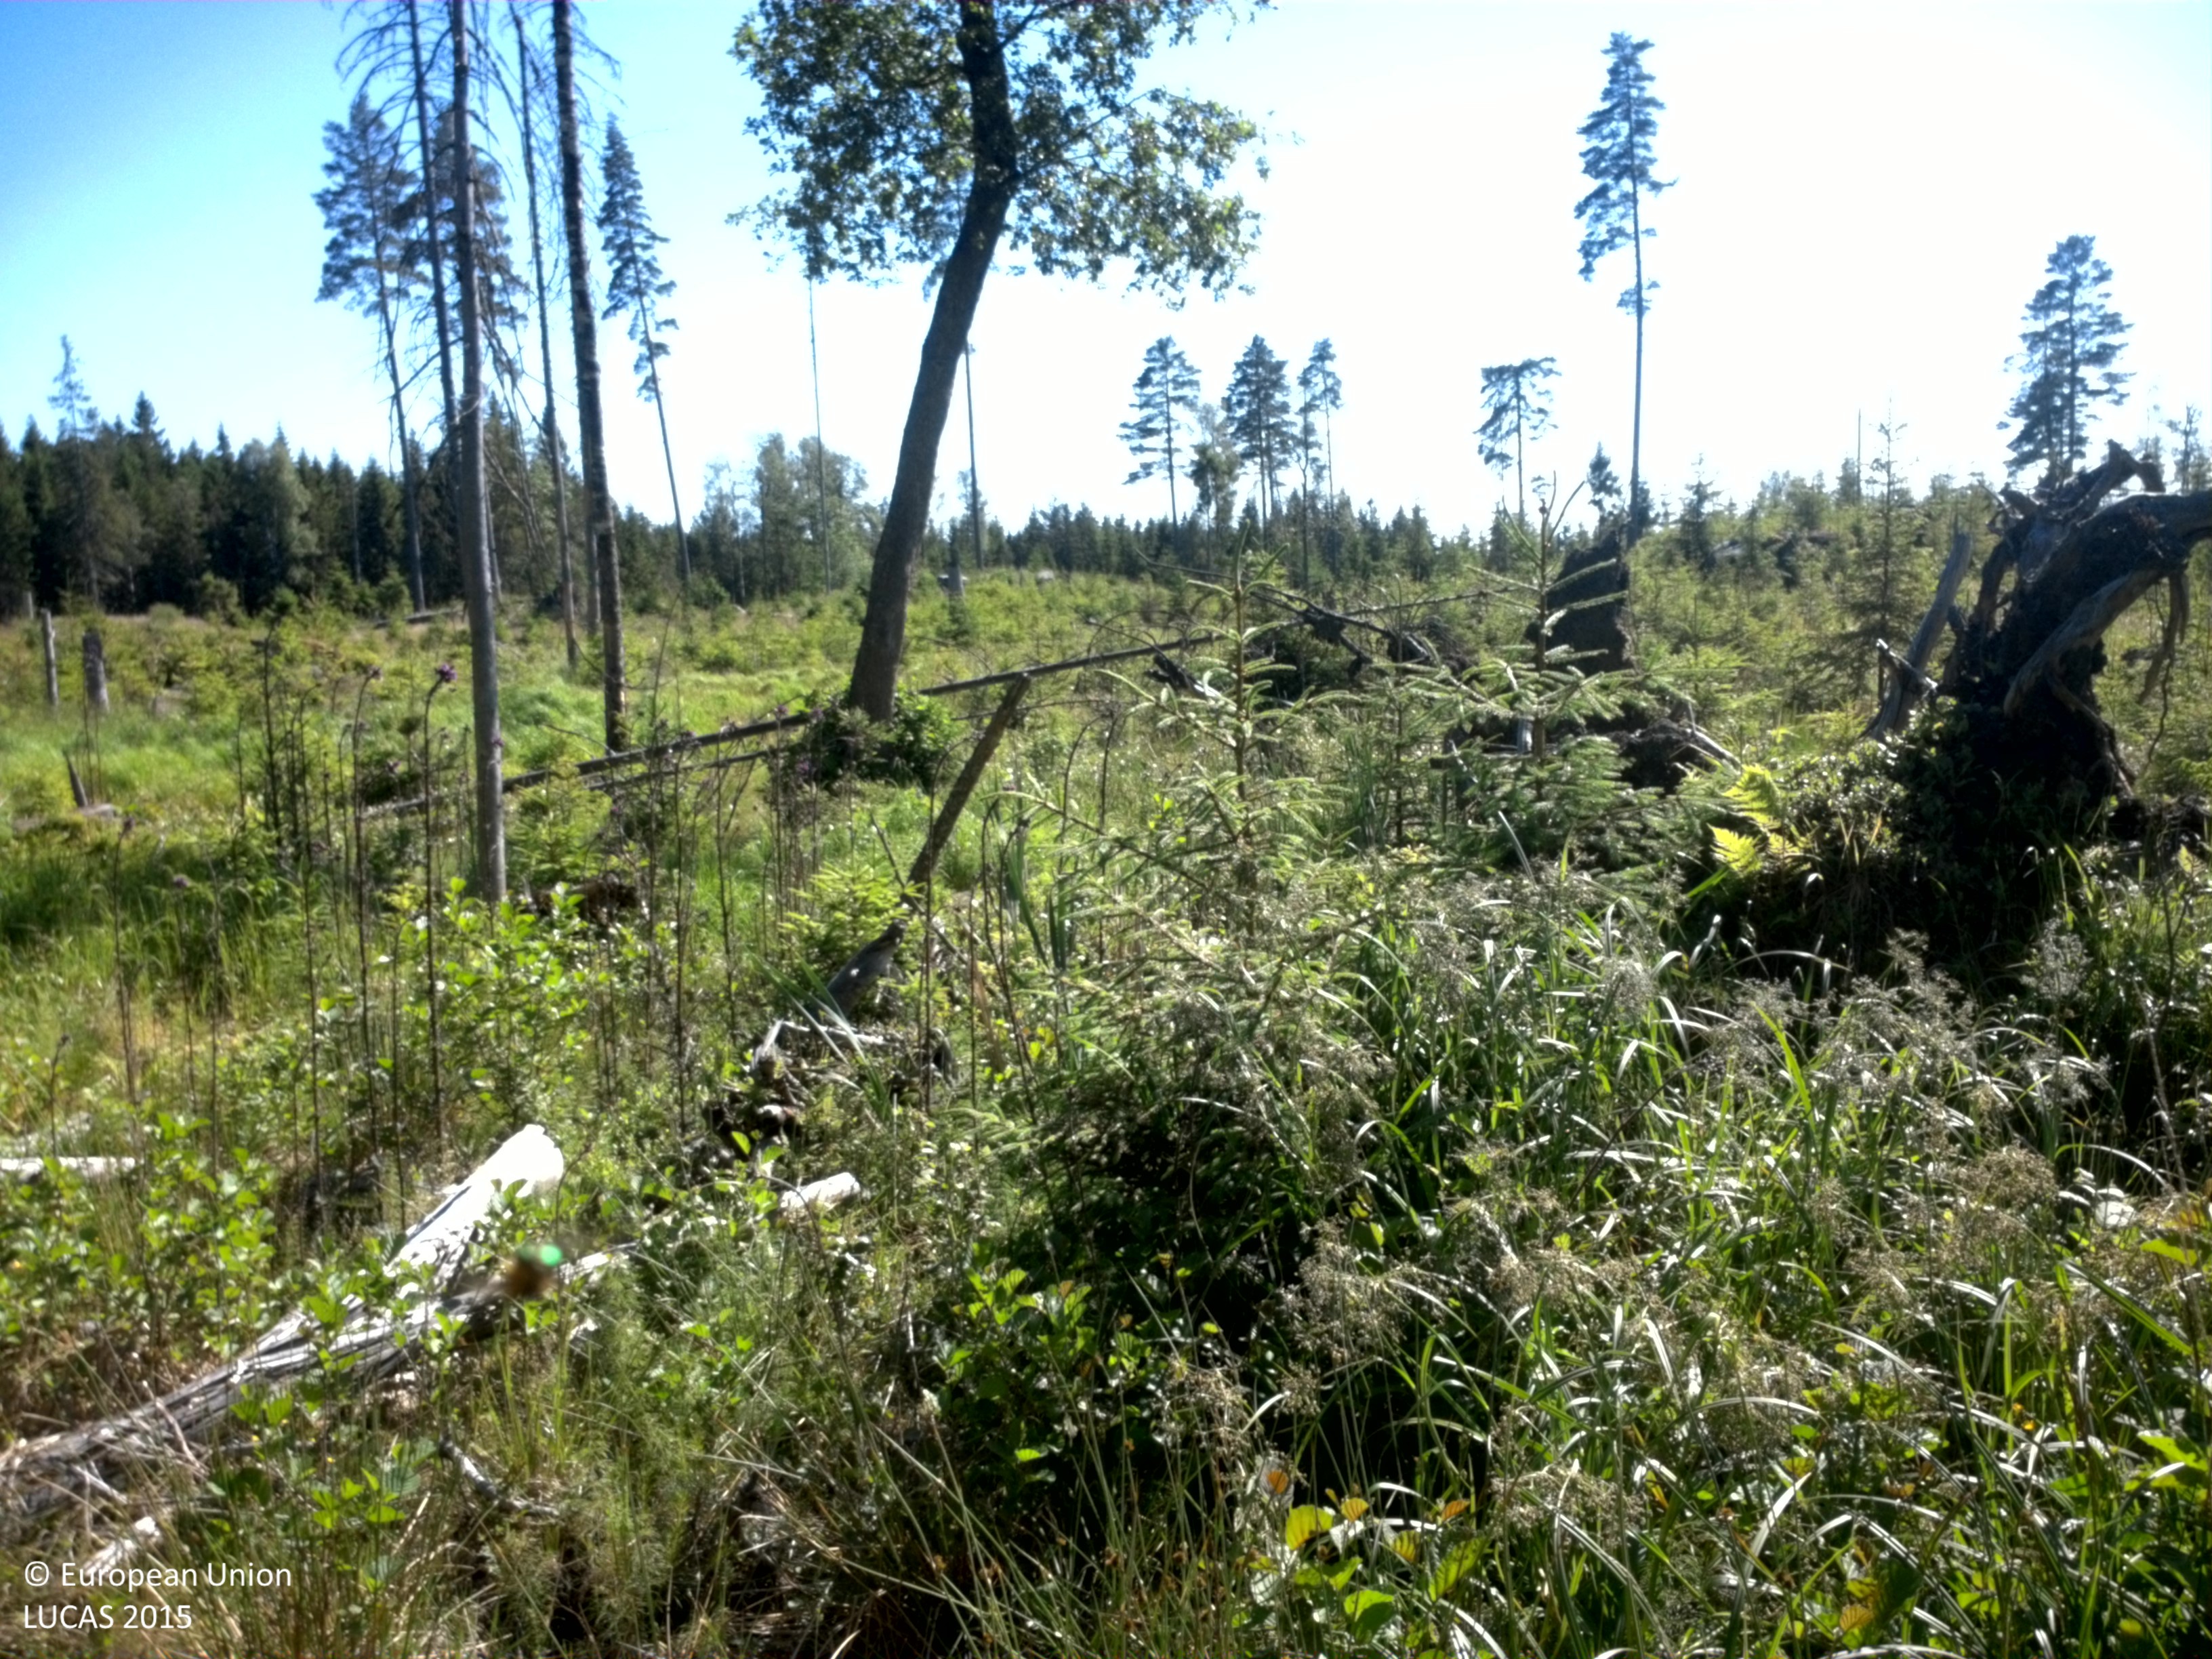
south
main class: Woodland
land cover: Spruce dominated mixed woodland
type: boreal forest
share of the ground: 25 - 50 %
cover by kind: herbaceous plants 30 %, coniferous forest trees 25 %, shrubs 25 %, broadleaved forest trees 20 %
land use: Forestry
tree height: < 5 m
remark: Clear cut
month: July
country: SE
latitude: 59.8231
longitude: 12.0808
